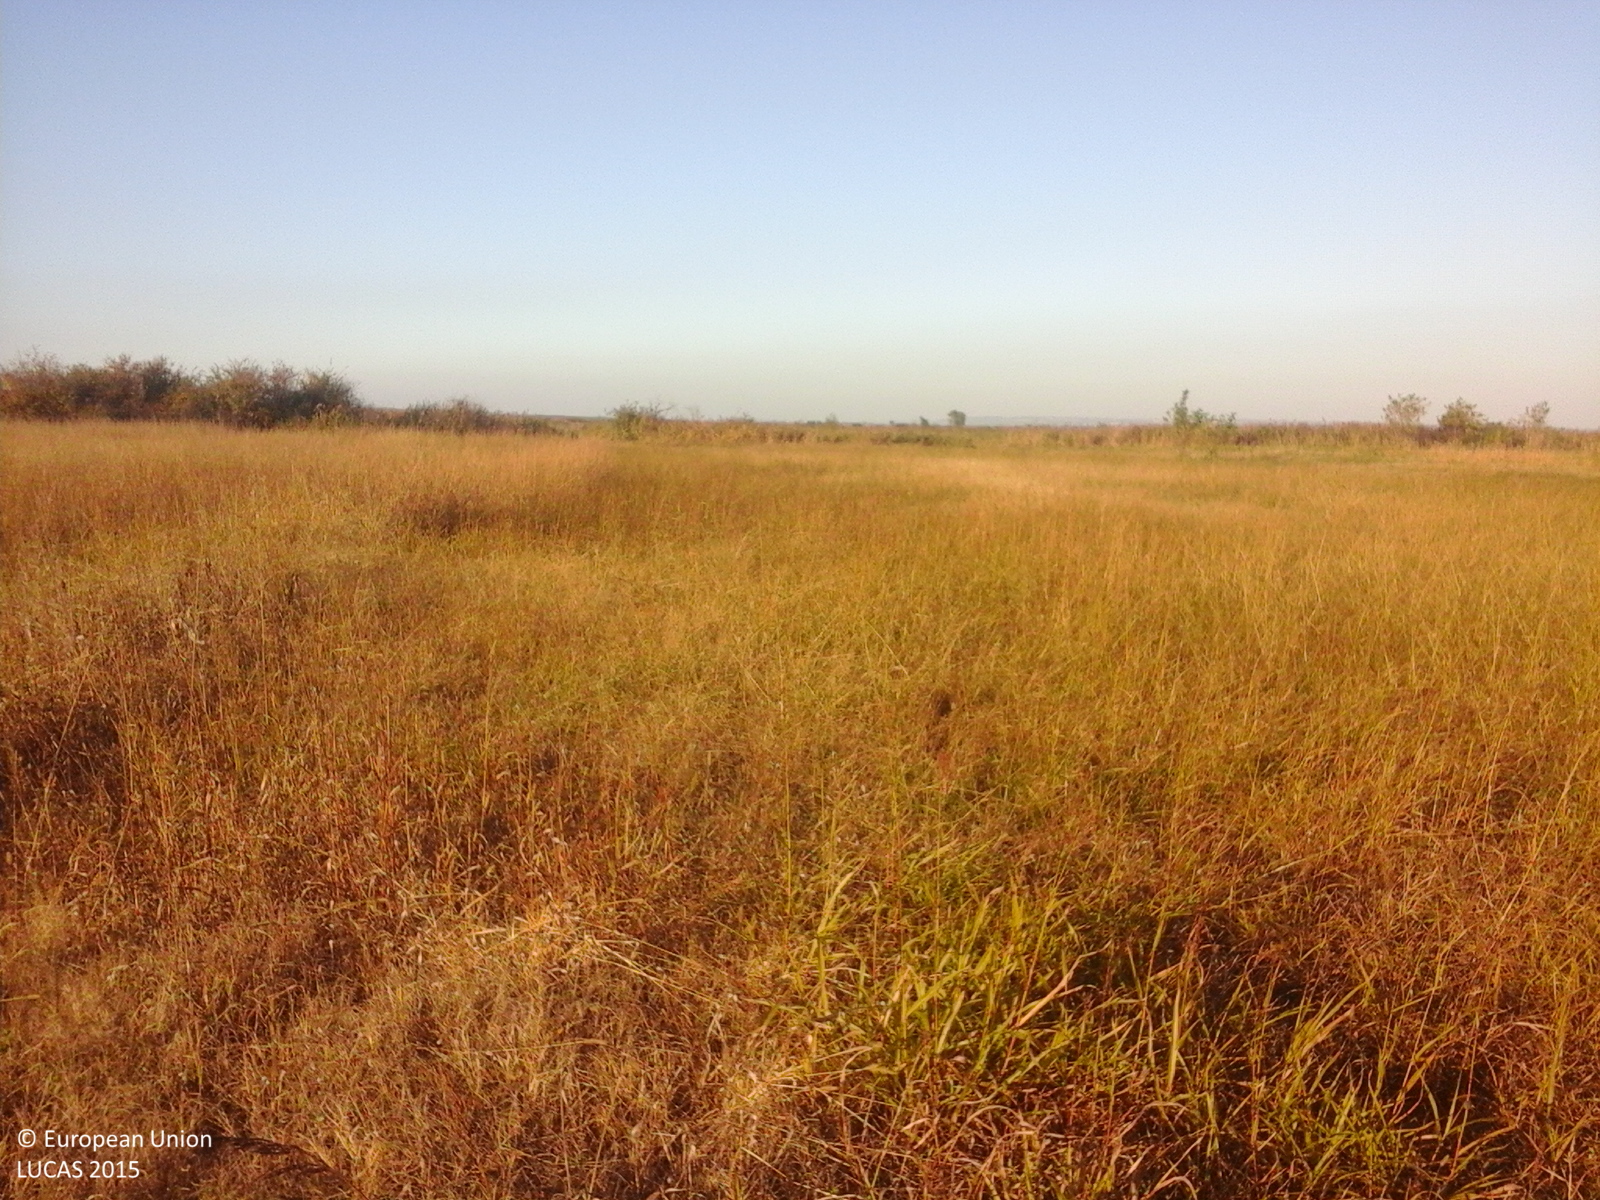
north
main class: Grassland
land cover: Spontaneously vegetated surfaces
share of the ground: > 75 %
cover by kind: herbaceous plants 100 %
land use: Fallow land
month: October
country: RO
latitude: 45.8219
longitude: 27.1227
